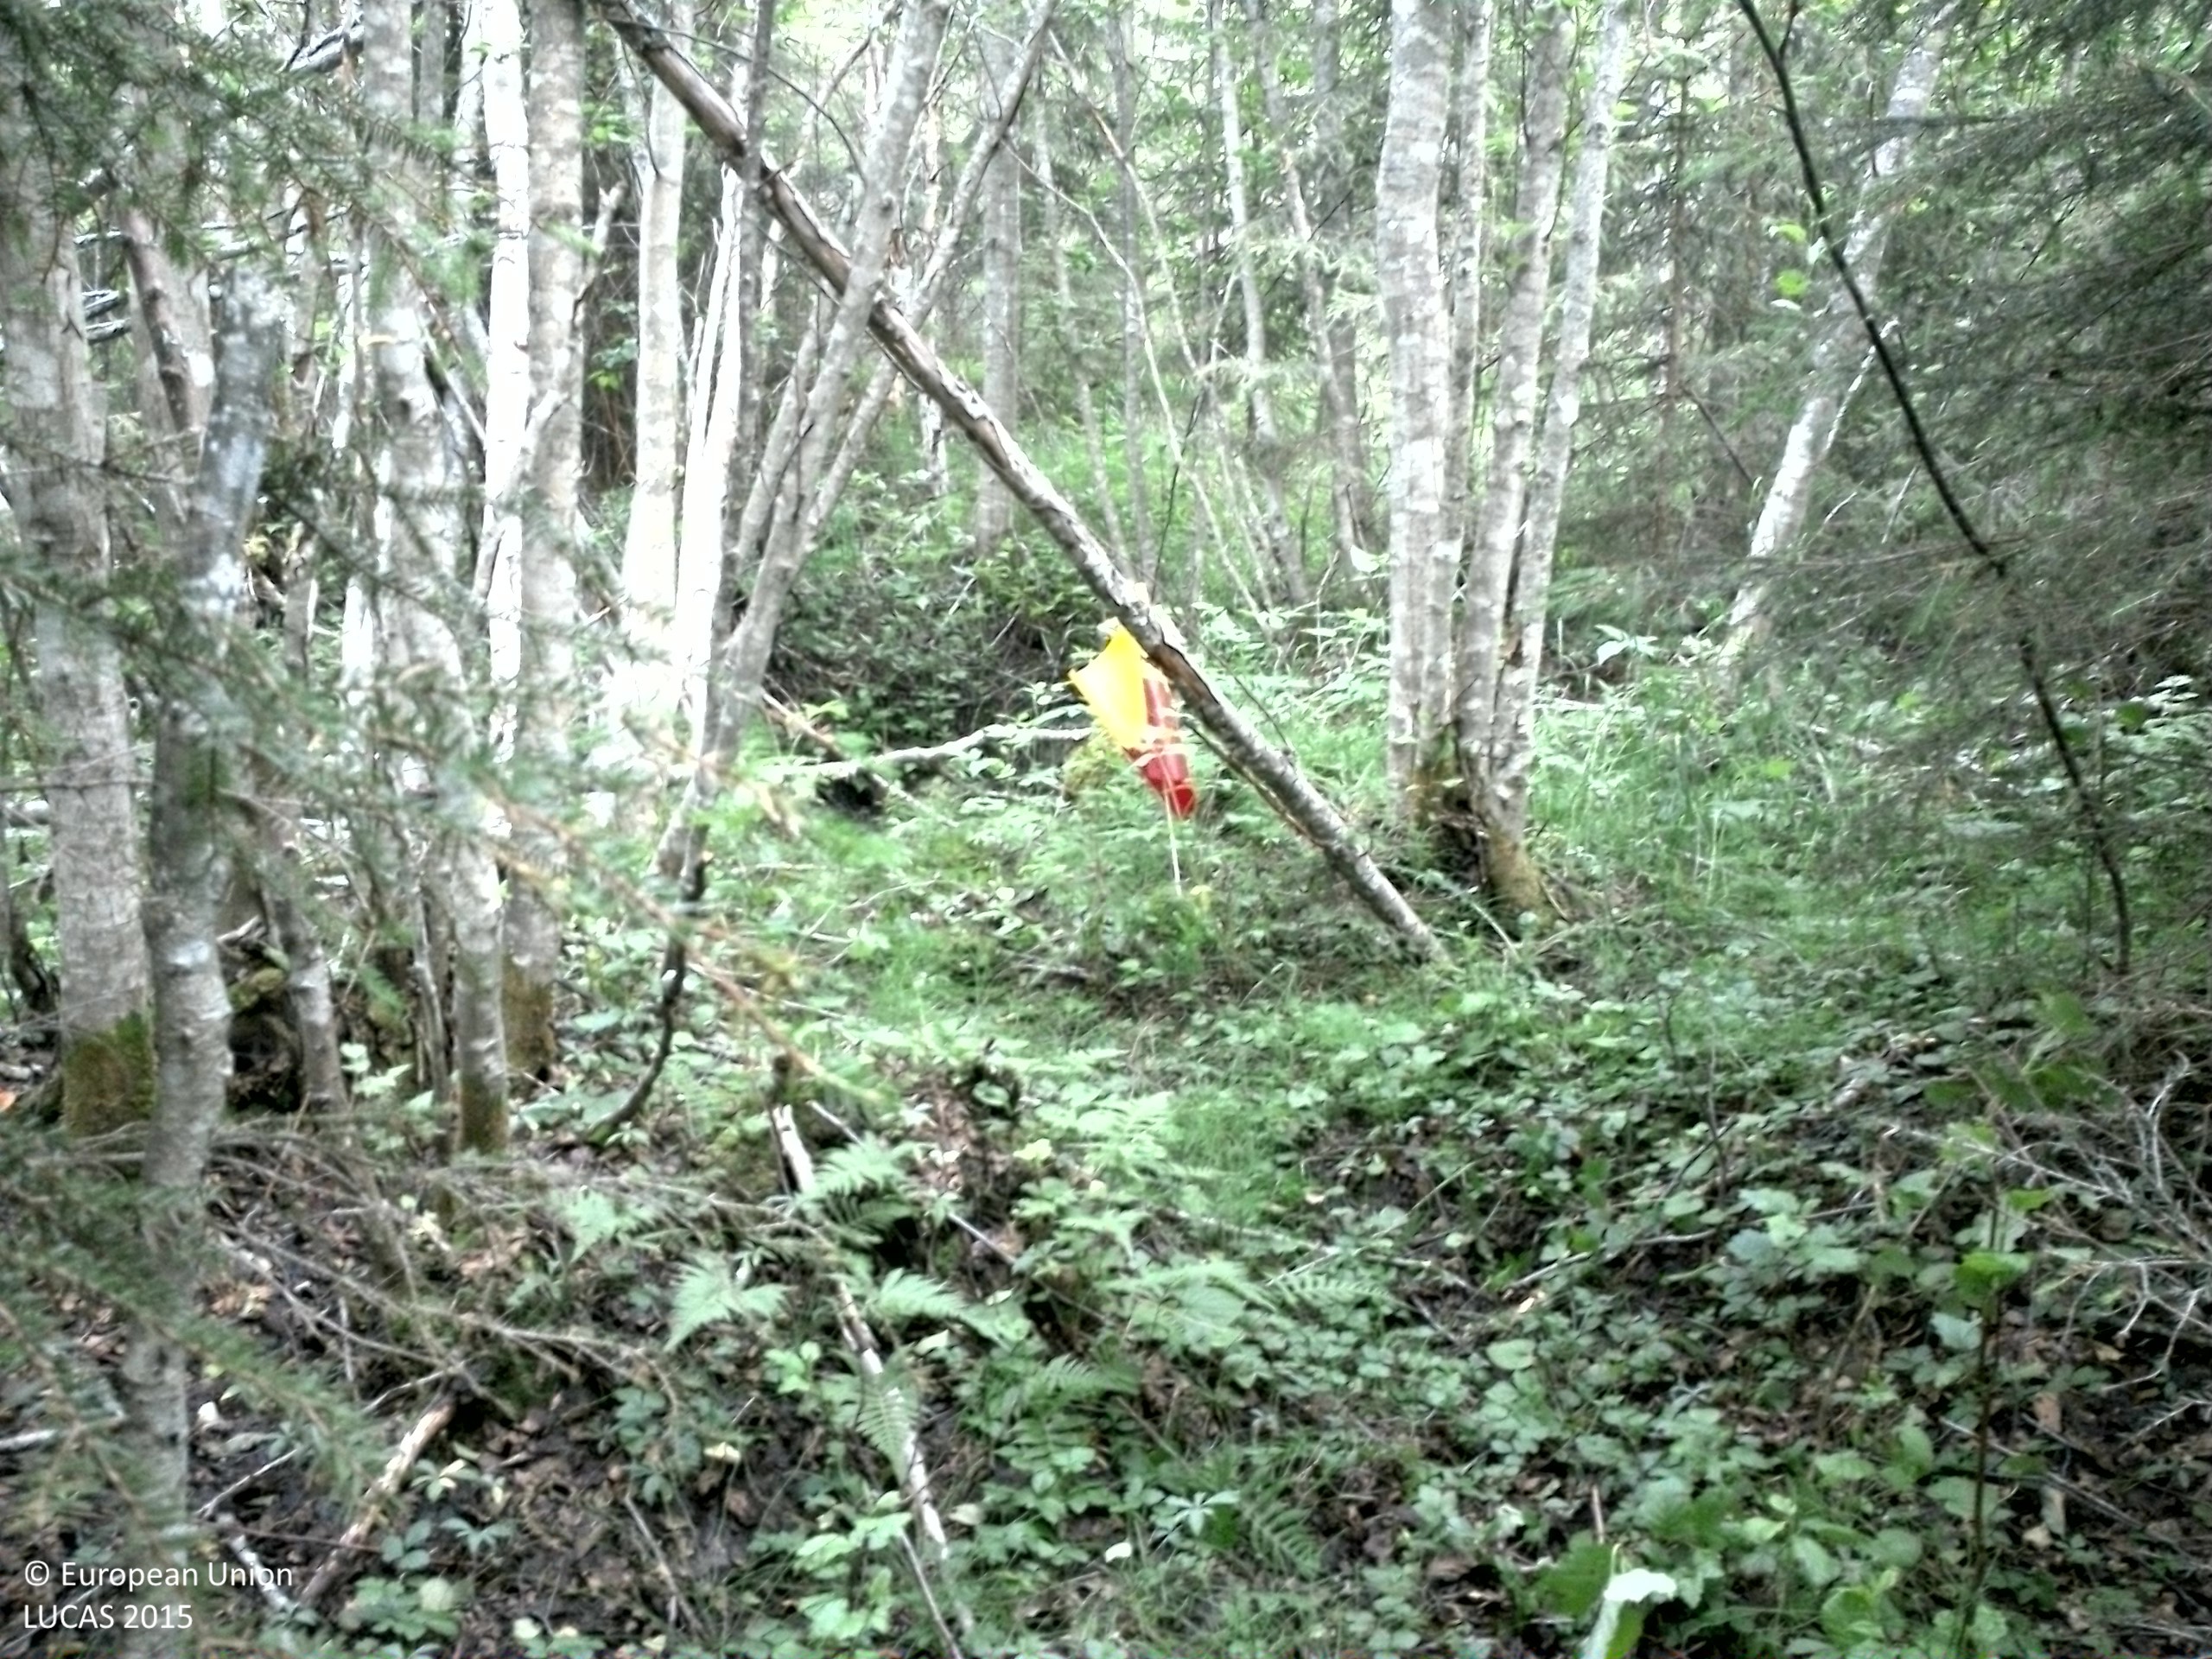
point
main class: Woodland
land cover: Spruce dominated mixed woodland
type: boreal forest
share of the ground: > 75 %
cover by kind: broadleaved forest trees 45 %, coniferous forest trees 40 %, herbaceous plants 10 %
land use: Forestry
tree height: > 5 m
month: August
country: SE
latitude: 63.7141
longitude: 16.6717
